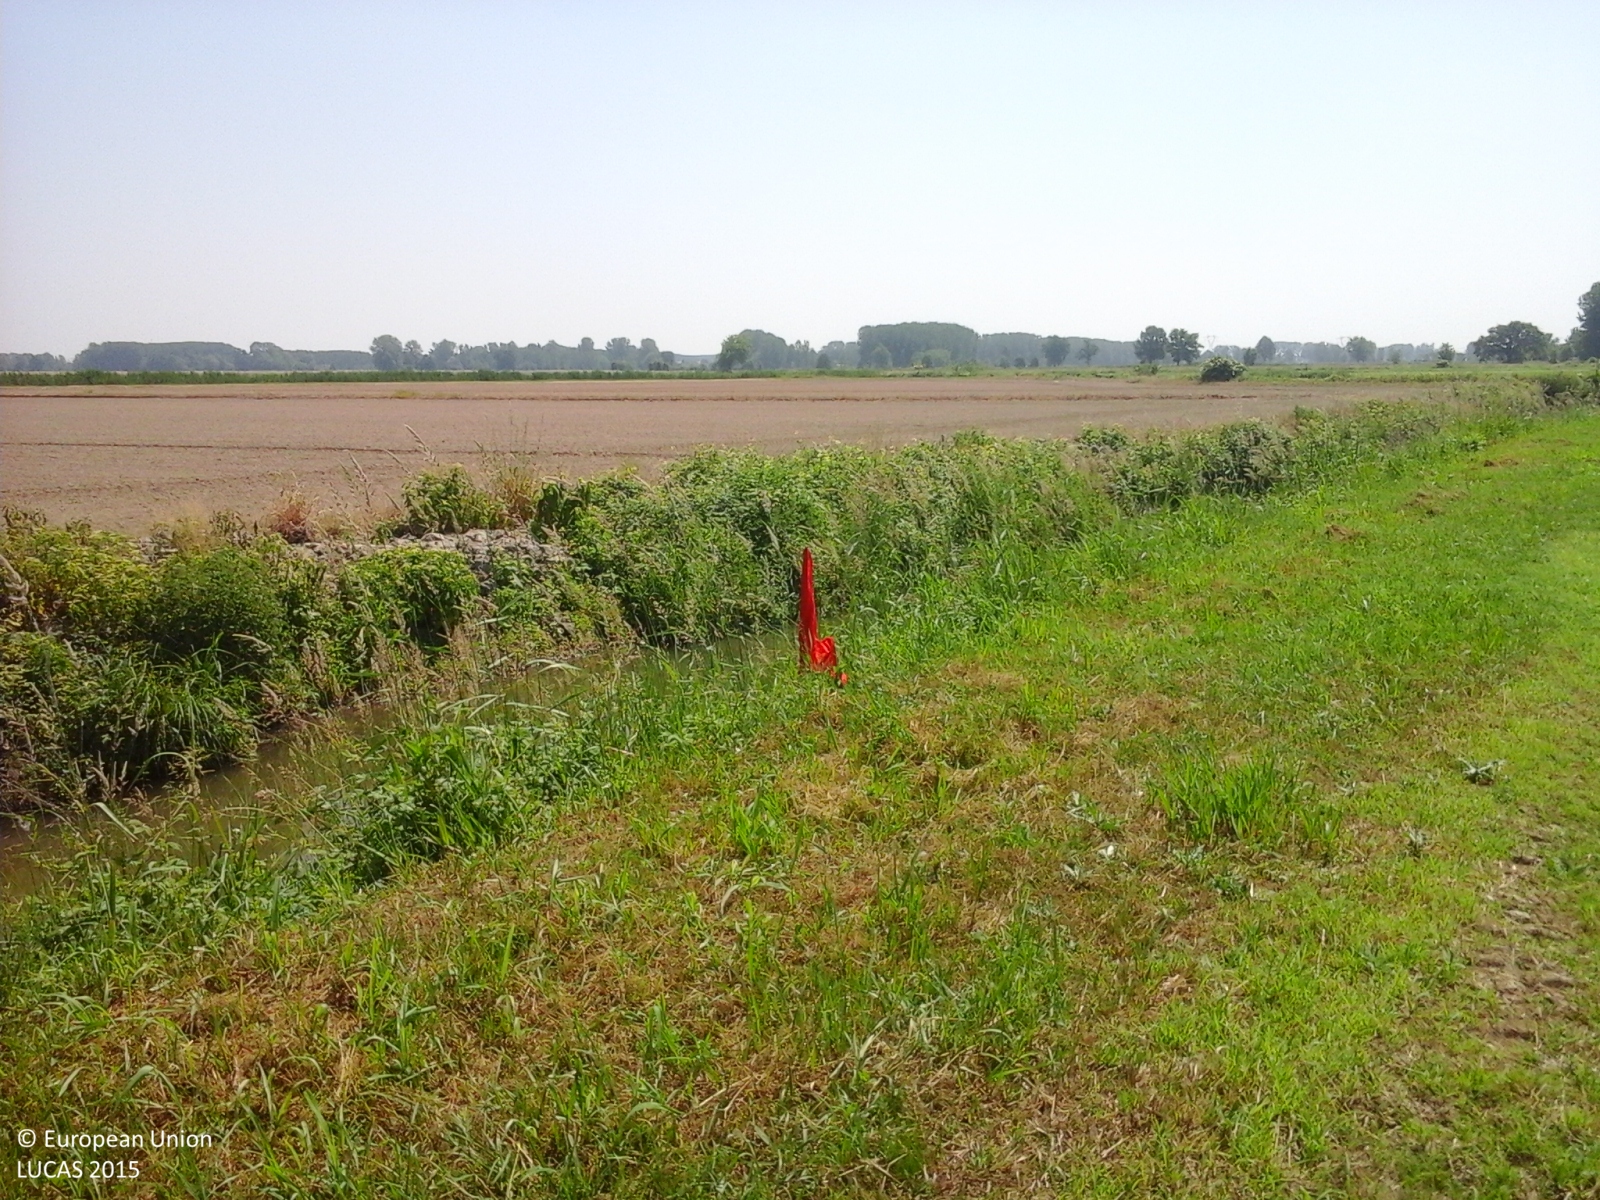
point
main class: Grassland
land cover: Spontaneously vegetated surfaces
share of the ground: > 75 %
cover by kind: herbaceous plants 100 %
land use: Semi-natural and natural areas not in use
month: May
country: IT
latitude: 45.2317
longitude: 9.3007
